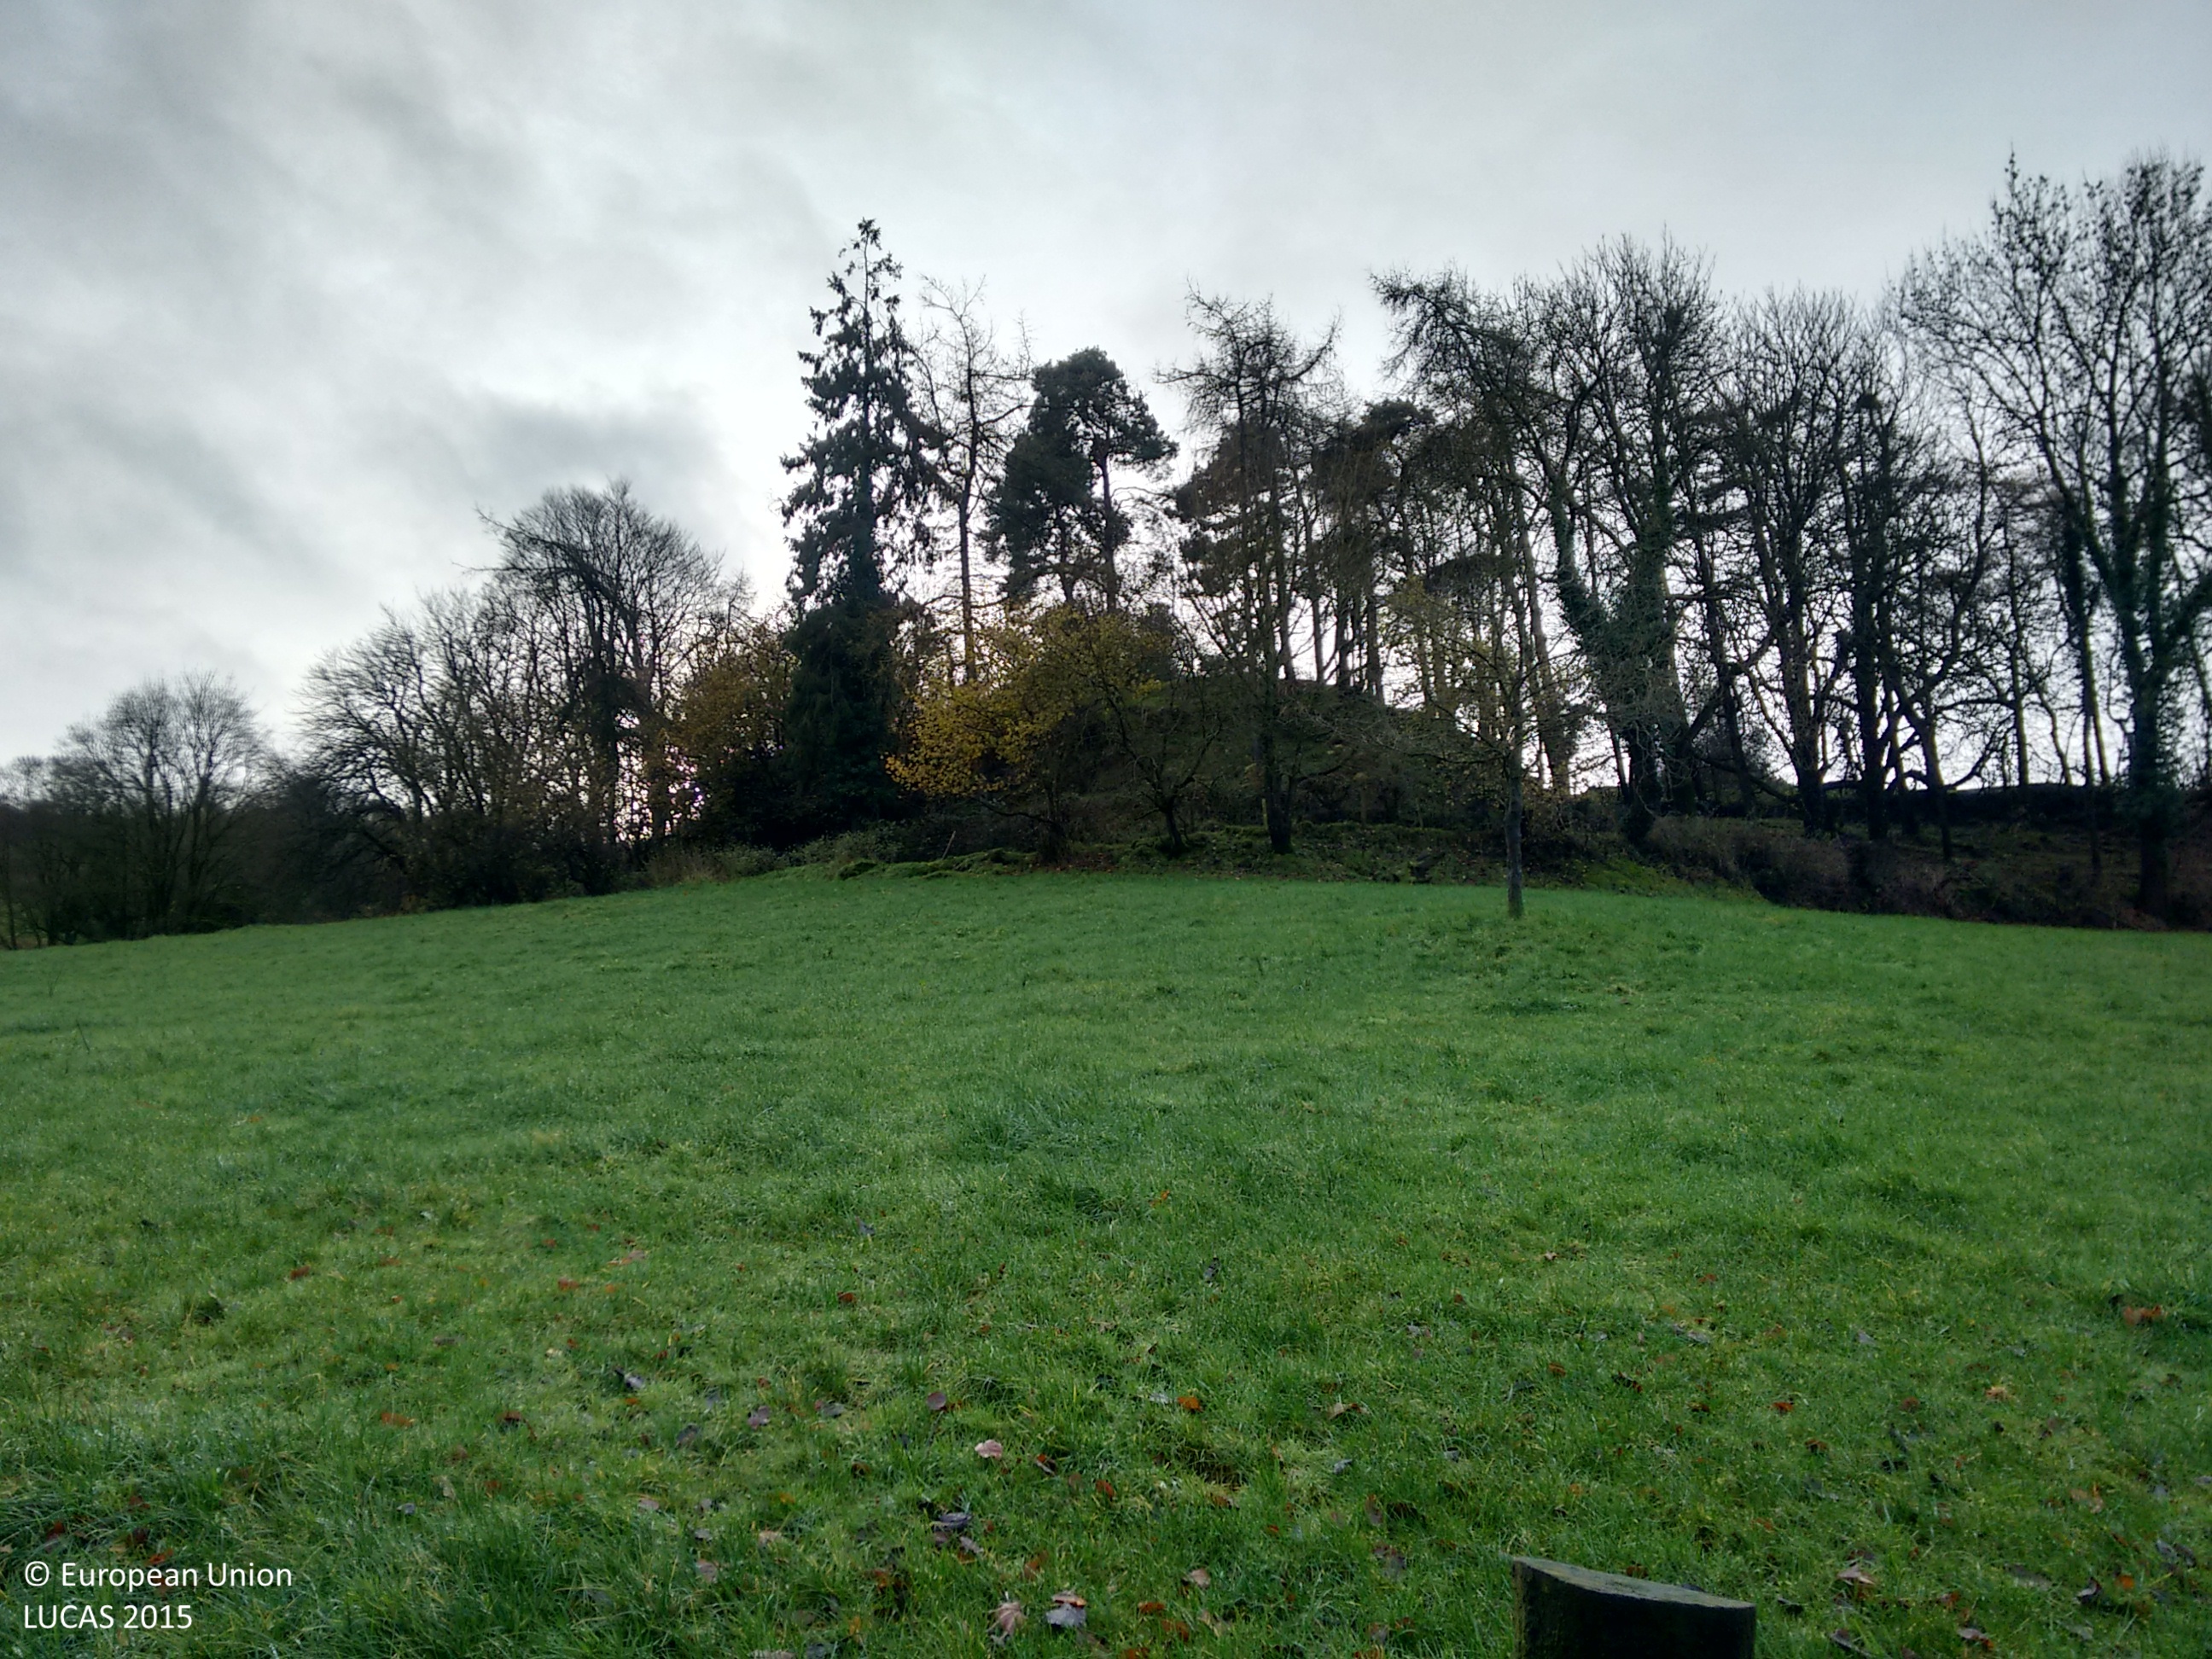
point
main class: Woodland
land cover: Broadleaved woodland
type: acidophilous oak and oak-birch forest
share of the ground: > 75 %
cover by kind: broadleaved forest trees 95 %, shrubs 5 %
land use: Semi-natural and natural areas not in use
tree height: > 5 m
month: December
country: IE
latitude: 53.9834
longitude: -7.1804
